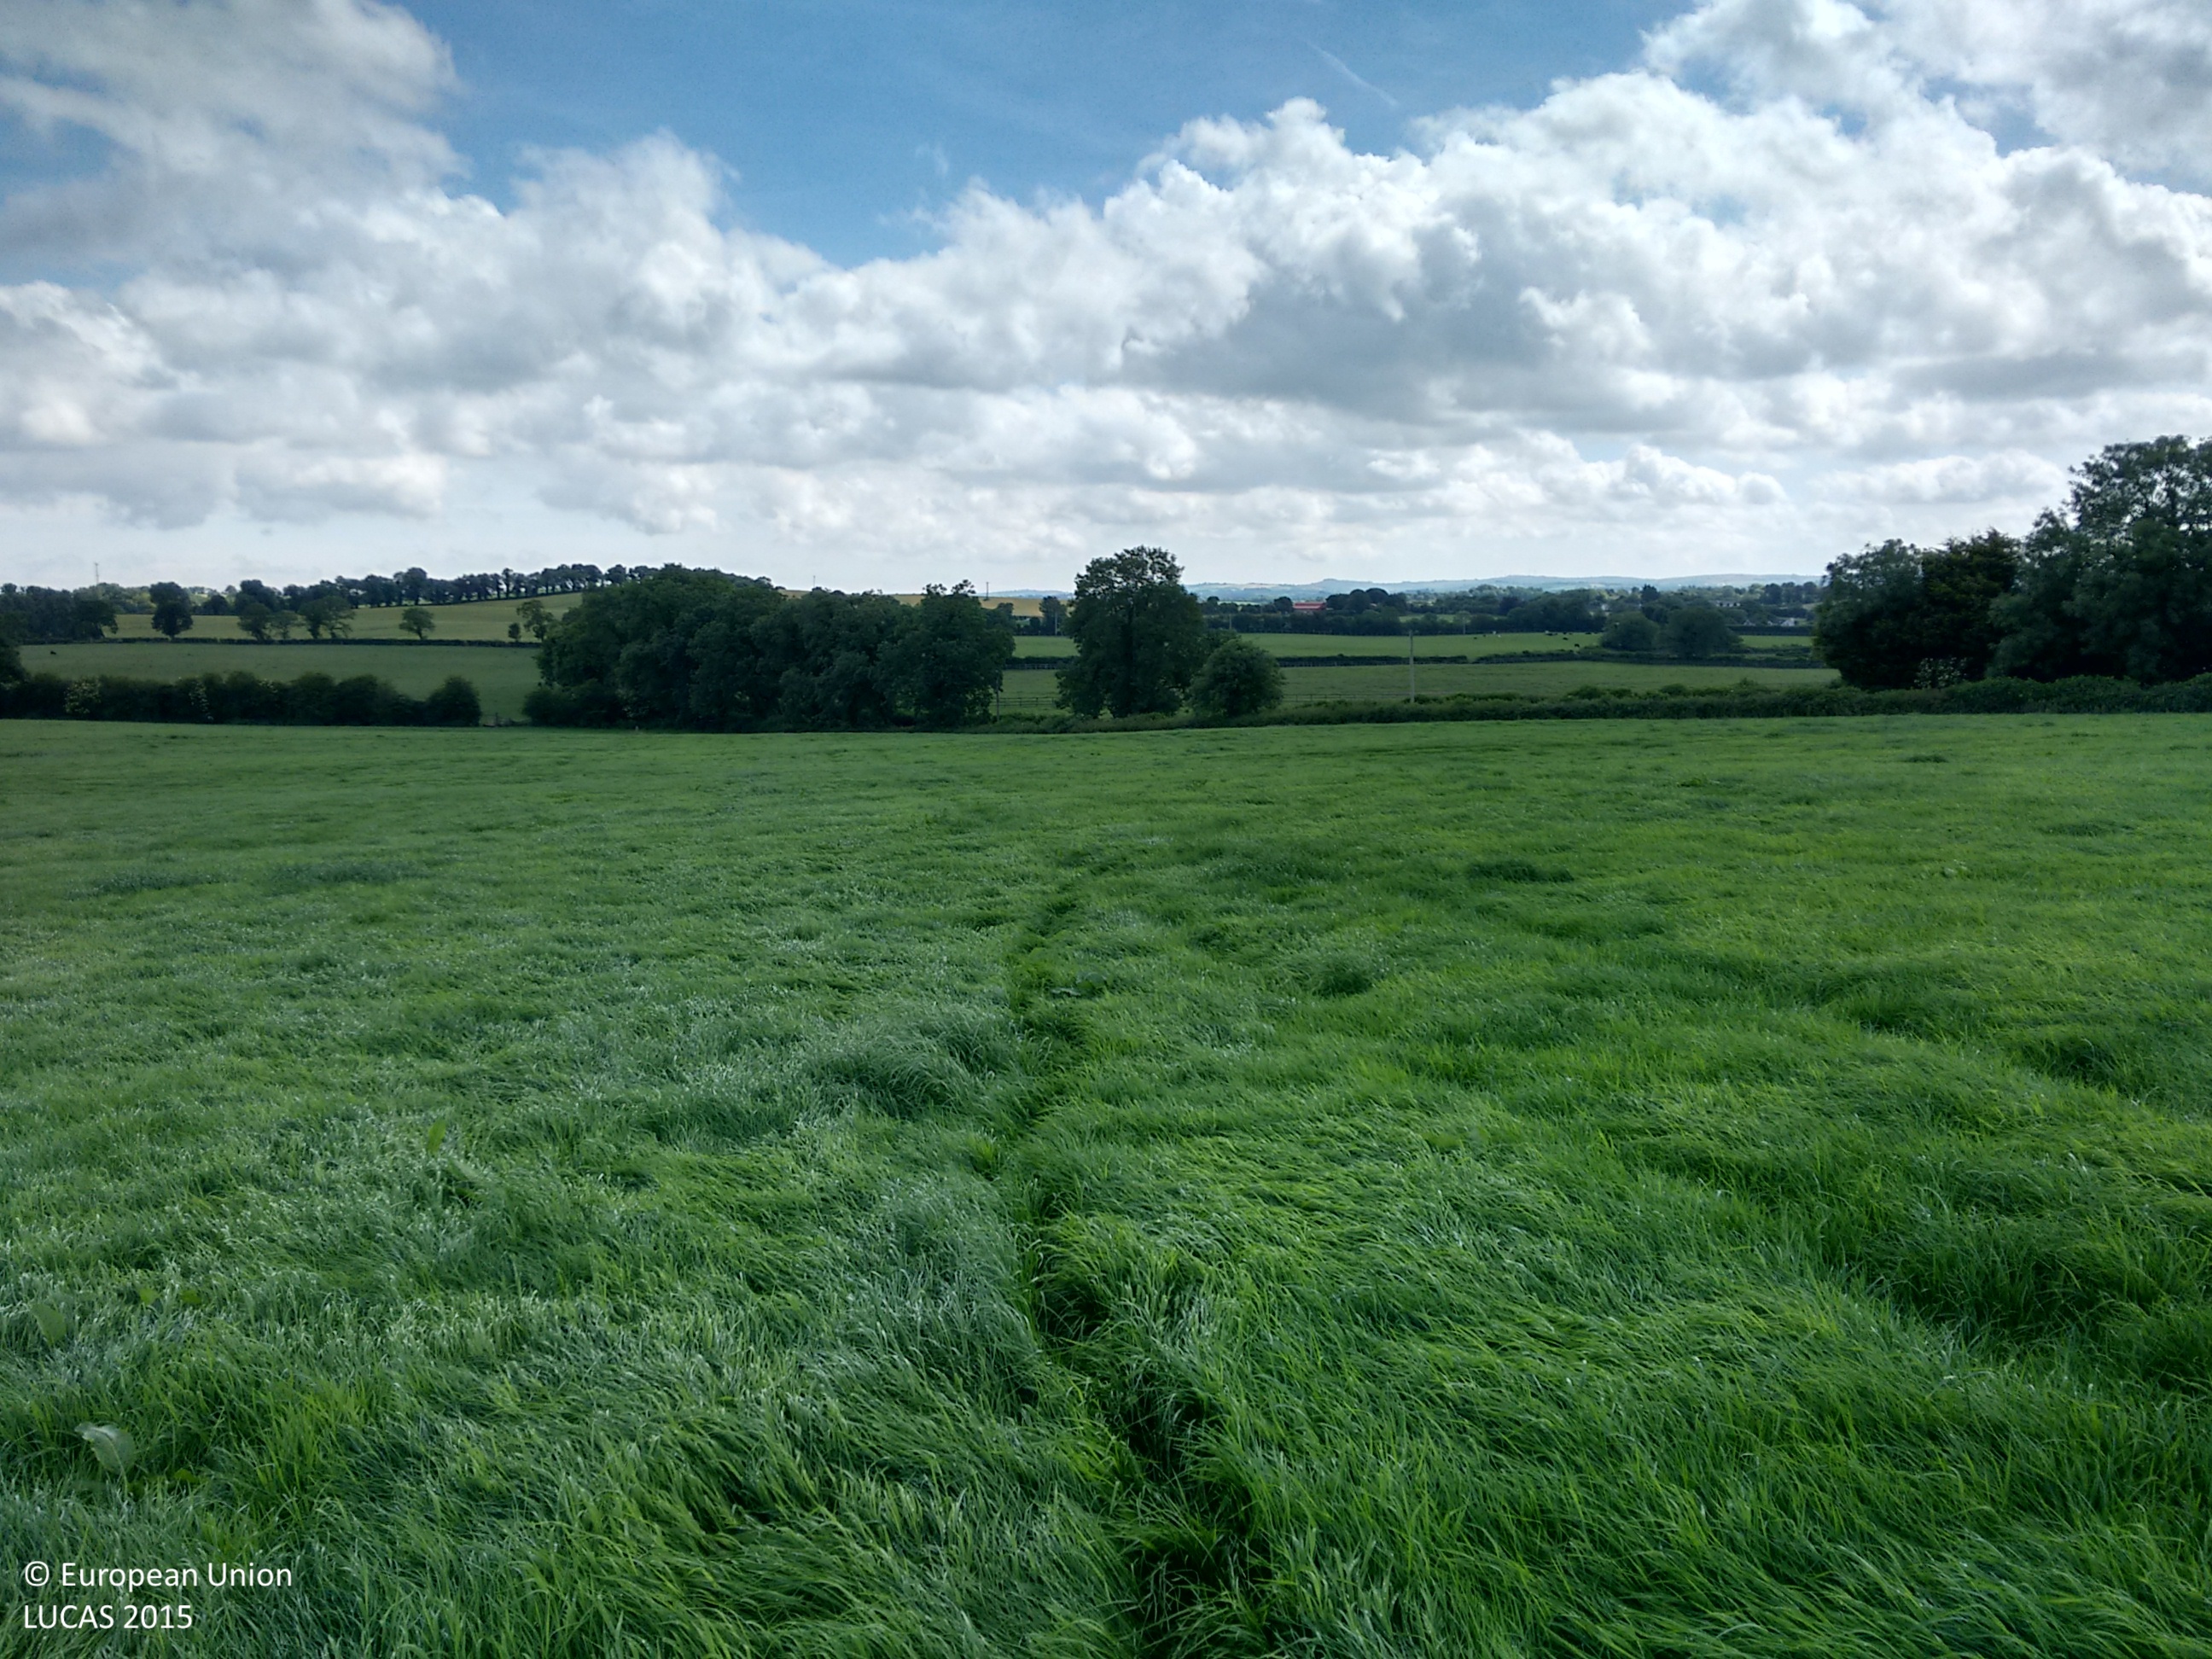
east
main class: Grassland
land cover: Grassland without tree/shrub cover
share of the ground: > 75 %
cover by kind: herbaceous plants 100 %
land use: Agriculture (excluding fallow land and kitchen gardens)
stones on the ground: < 10 %
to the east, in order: Grassland without tree/shrub cover; Managed hedges; Shruby margins; Paved roads, cycling and walking lanes; Shruby margins; Electric lines; Managed hedges; Grassland without tree/shrub cover
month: July
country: IE
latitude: 53.7858
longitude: -6.7534
